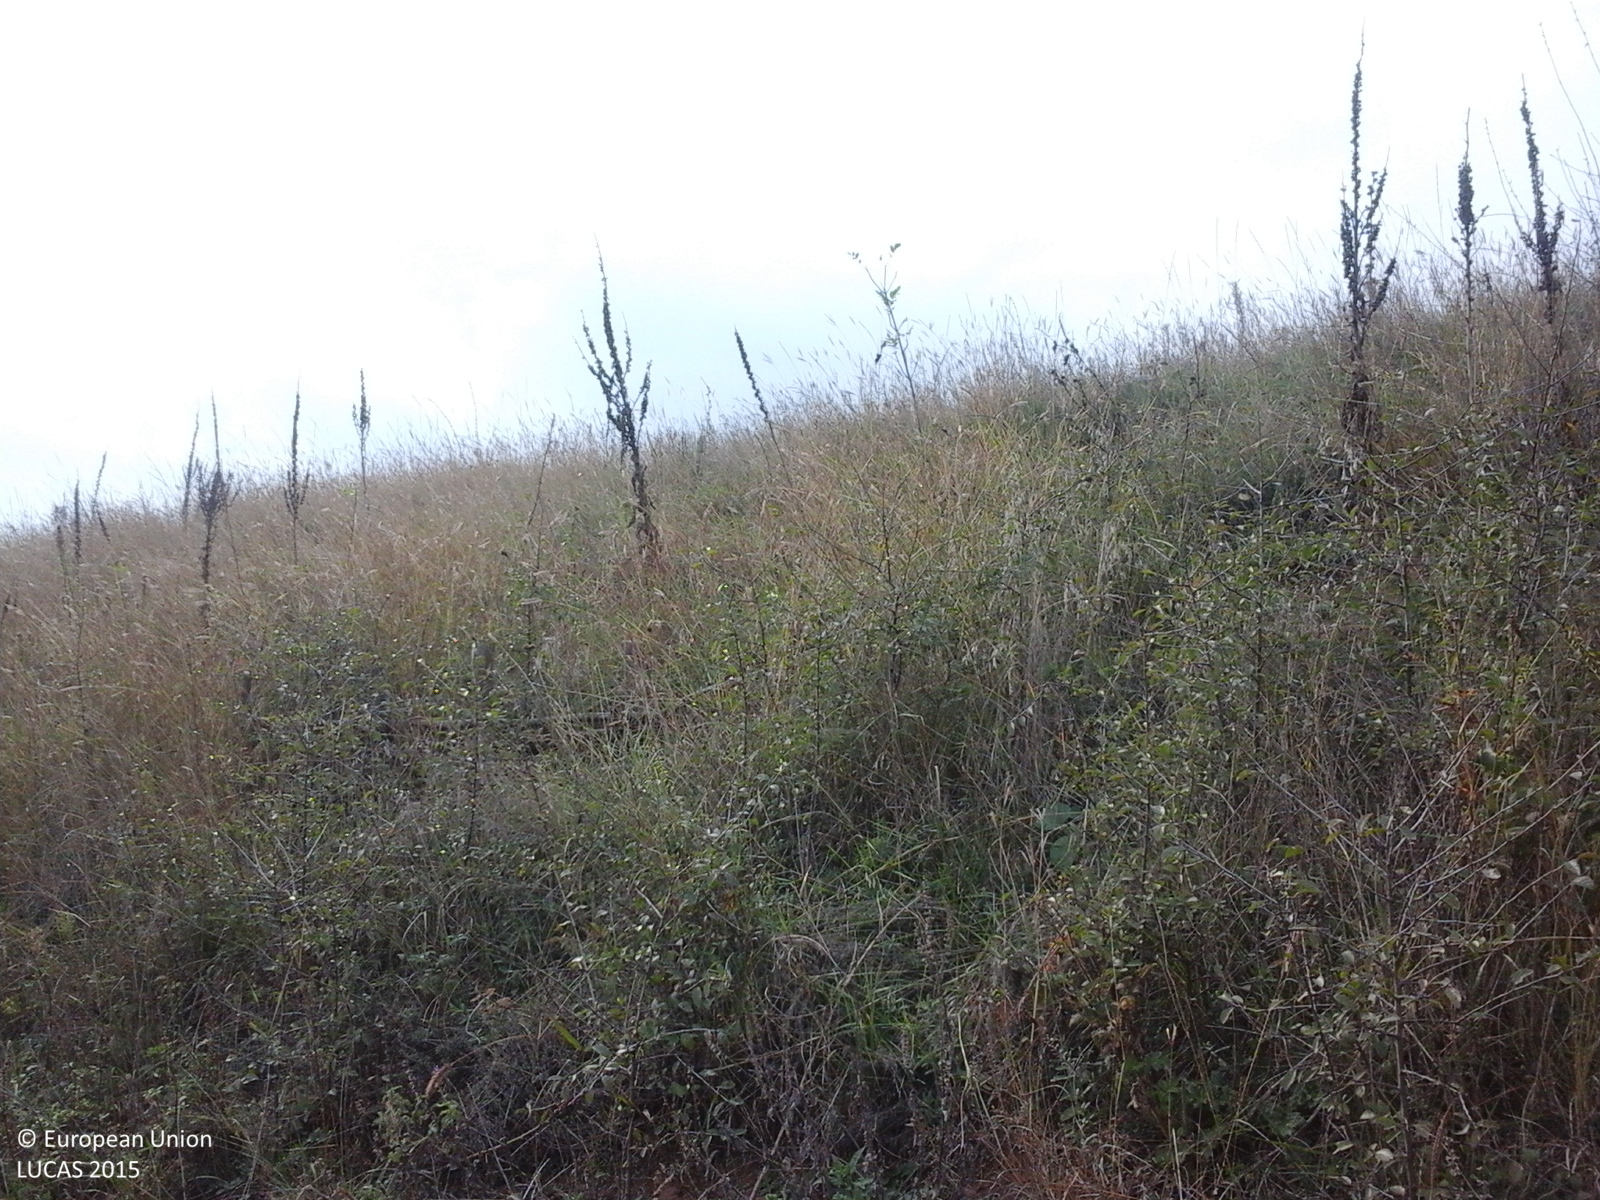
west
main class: Grassland
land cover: Grassland with sparse tree/shrub cover
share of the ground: > 75 %
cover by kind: herbaceous plants 95 %, broadleaved forest trees 5 %
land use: Agriculture (excluding fallow land and kitchen gardens)
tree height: < 5 m
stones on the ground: < 10 %
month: October
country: RO
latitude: 46.4380
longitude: 23.9368
